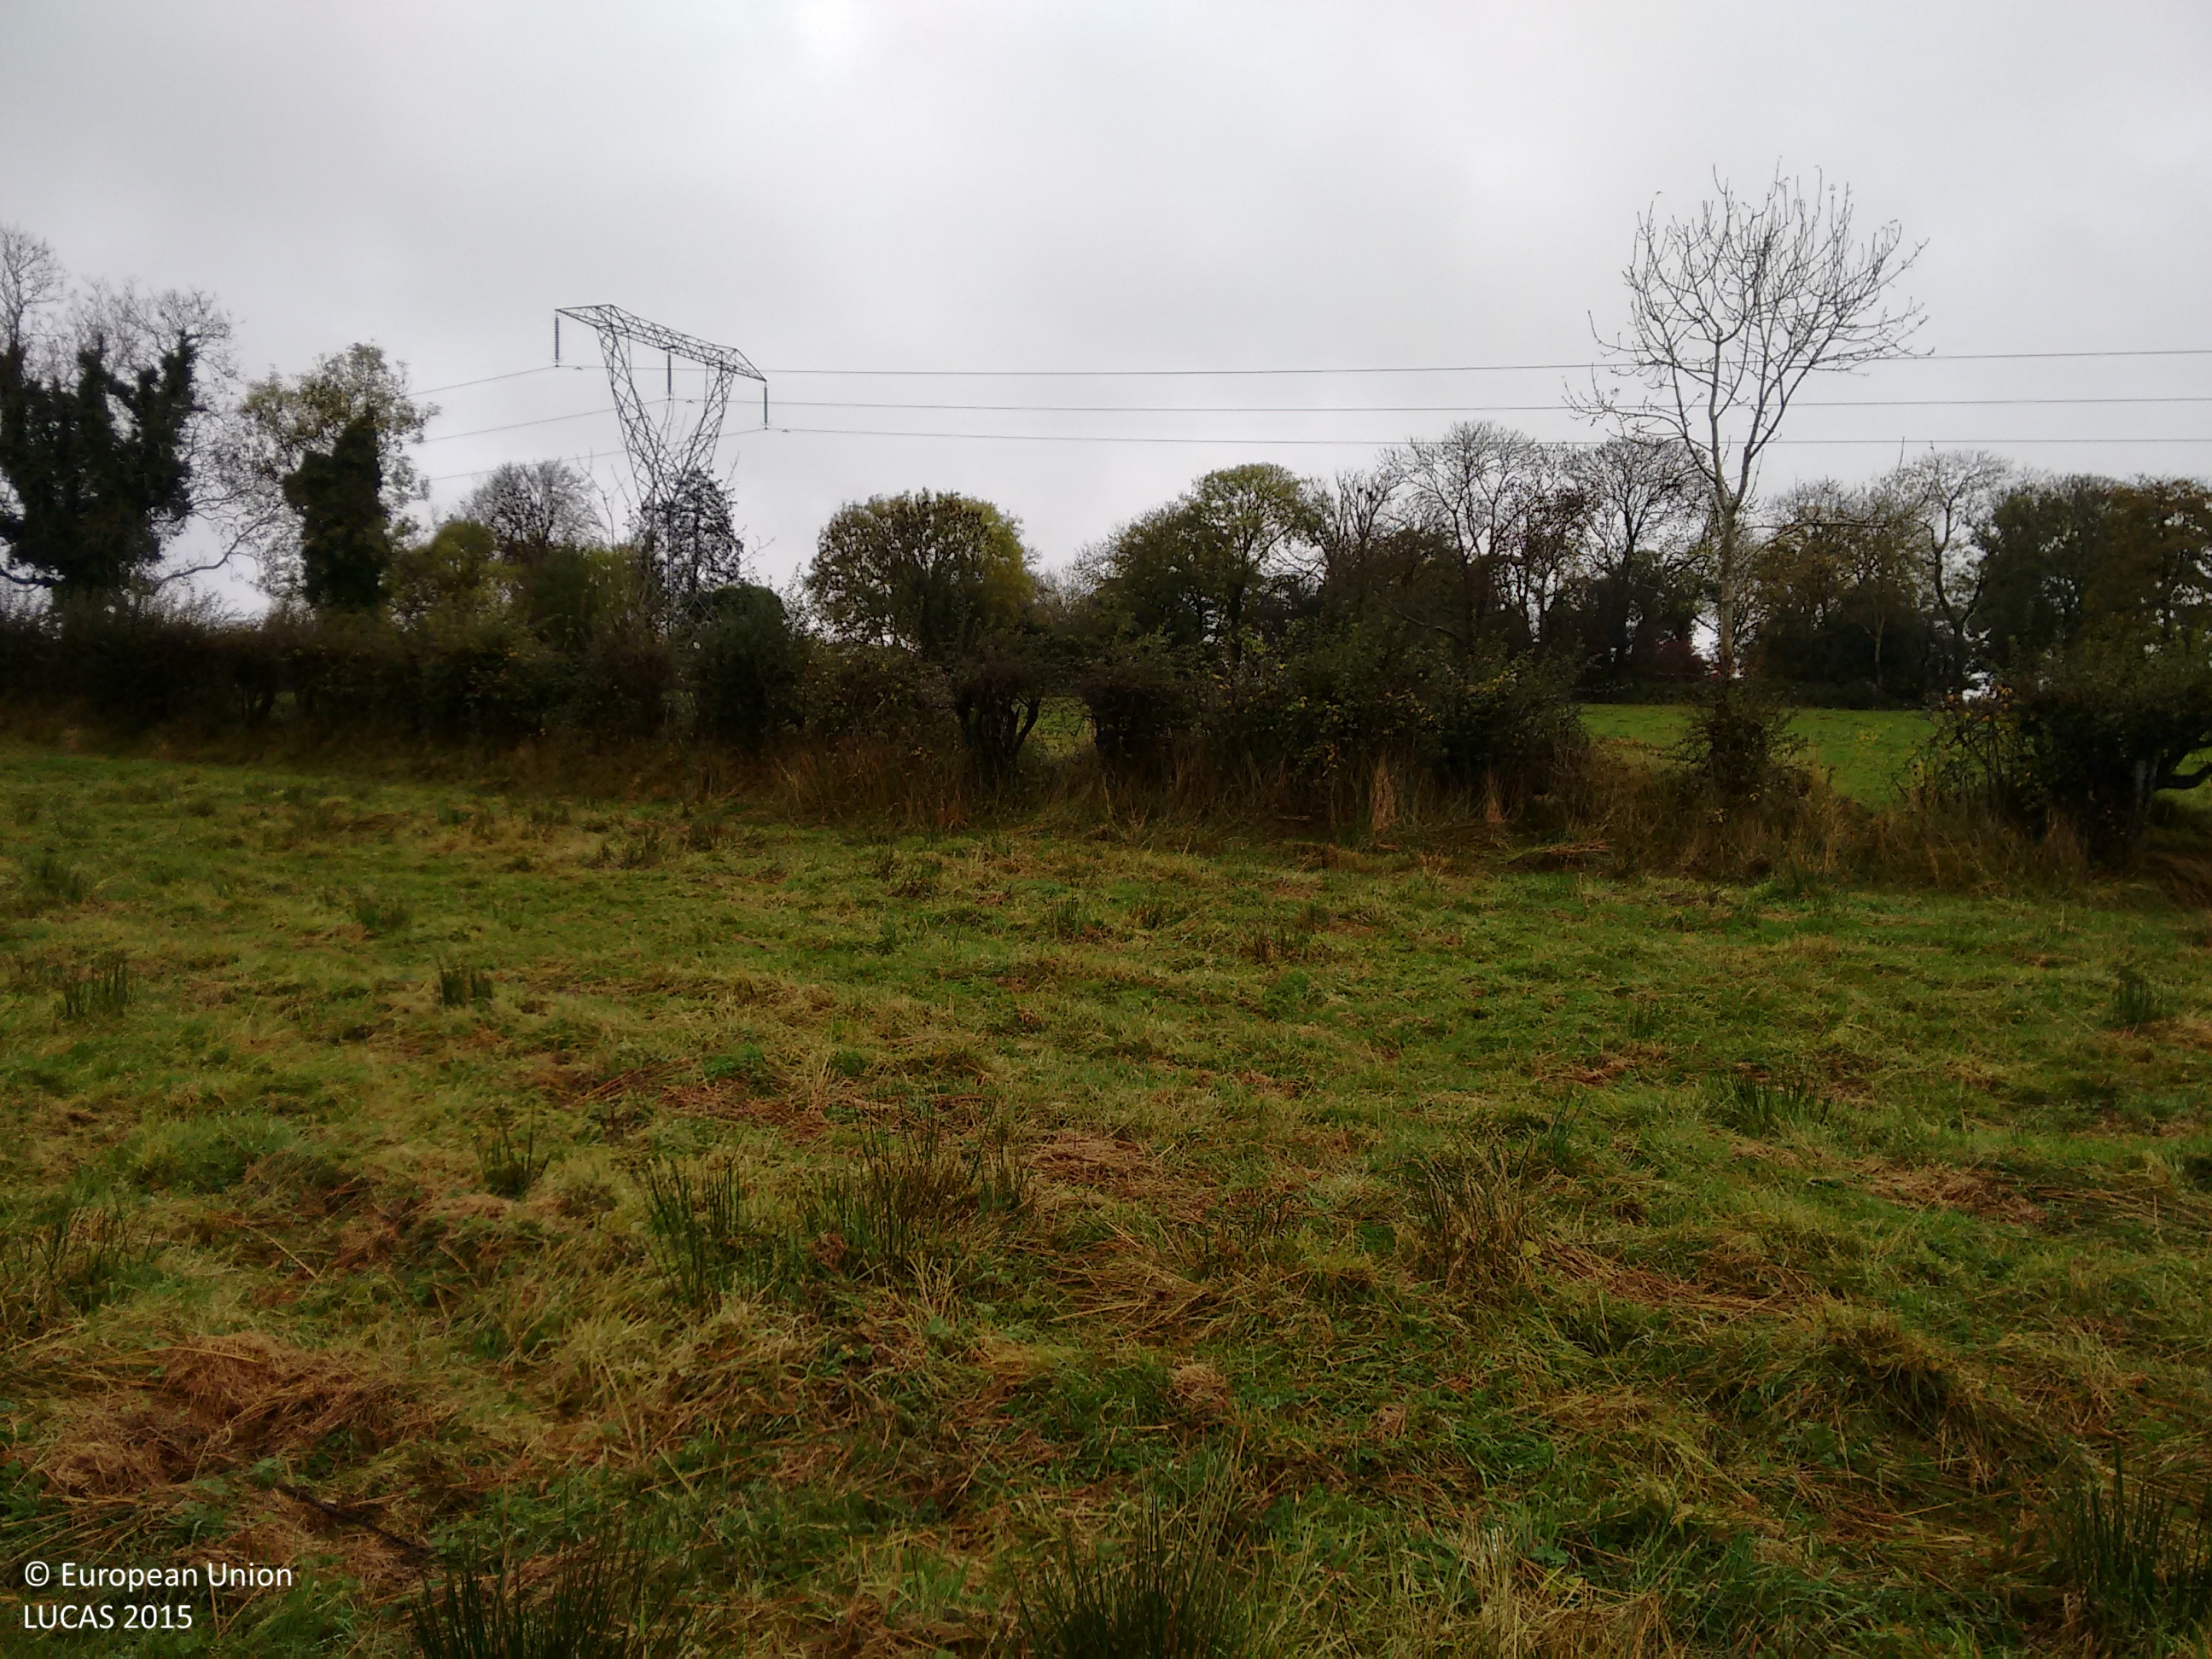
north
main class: Grassland
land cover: Grassland without tree/shrub cover
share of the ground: > 75 %
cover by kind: herbaceous plants 100 %
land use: Agriculture (excluding fallow land and kitchen gardens)
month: October
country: IE
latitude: 53.8967
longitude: -8.0260
